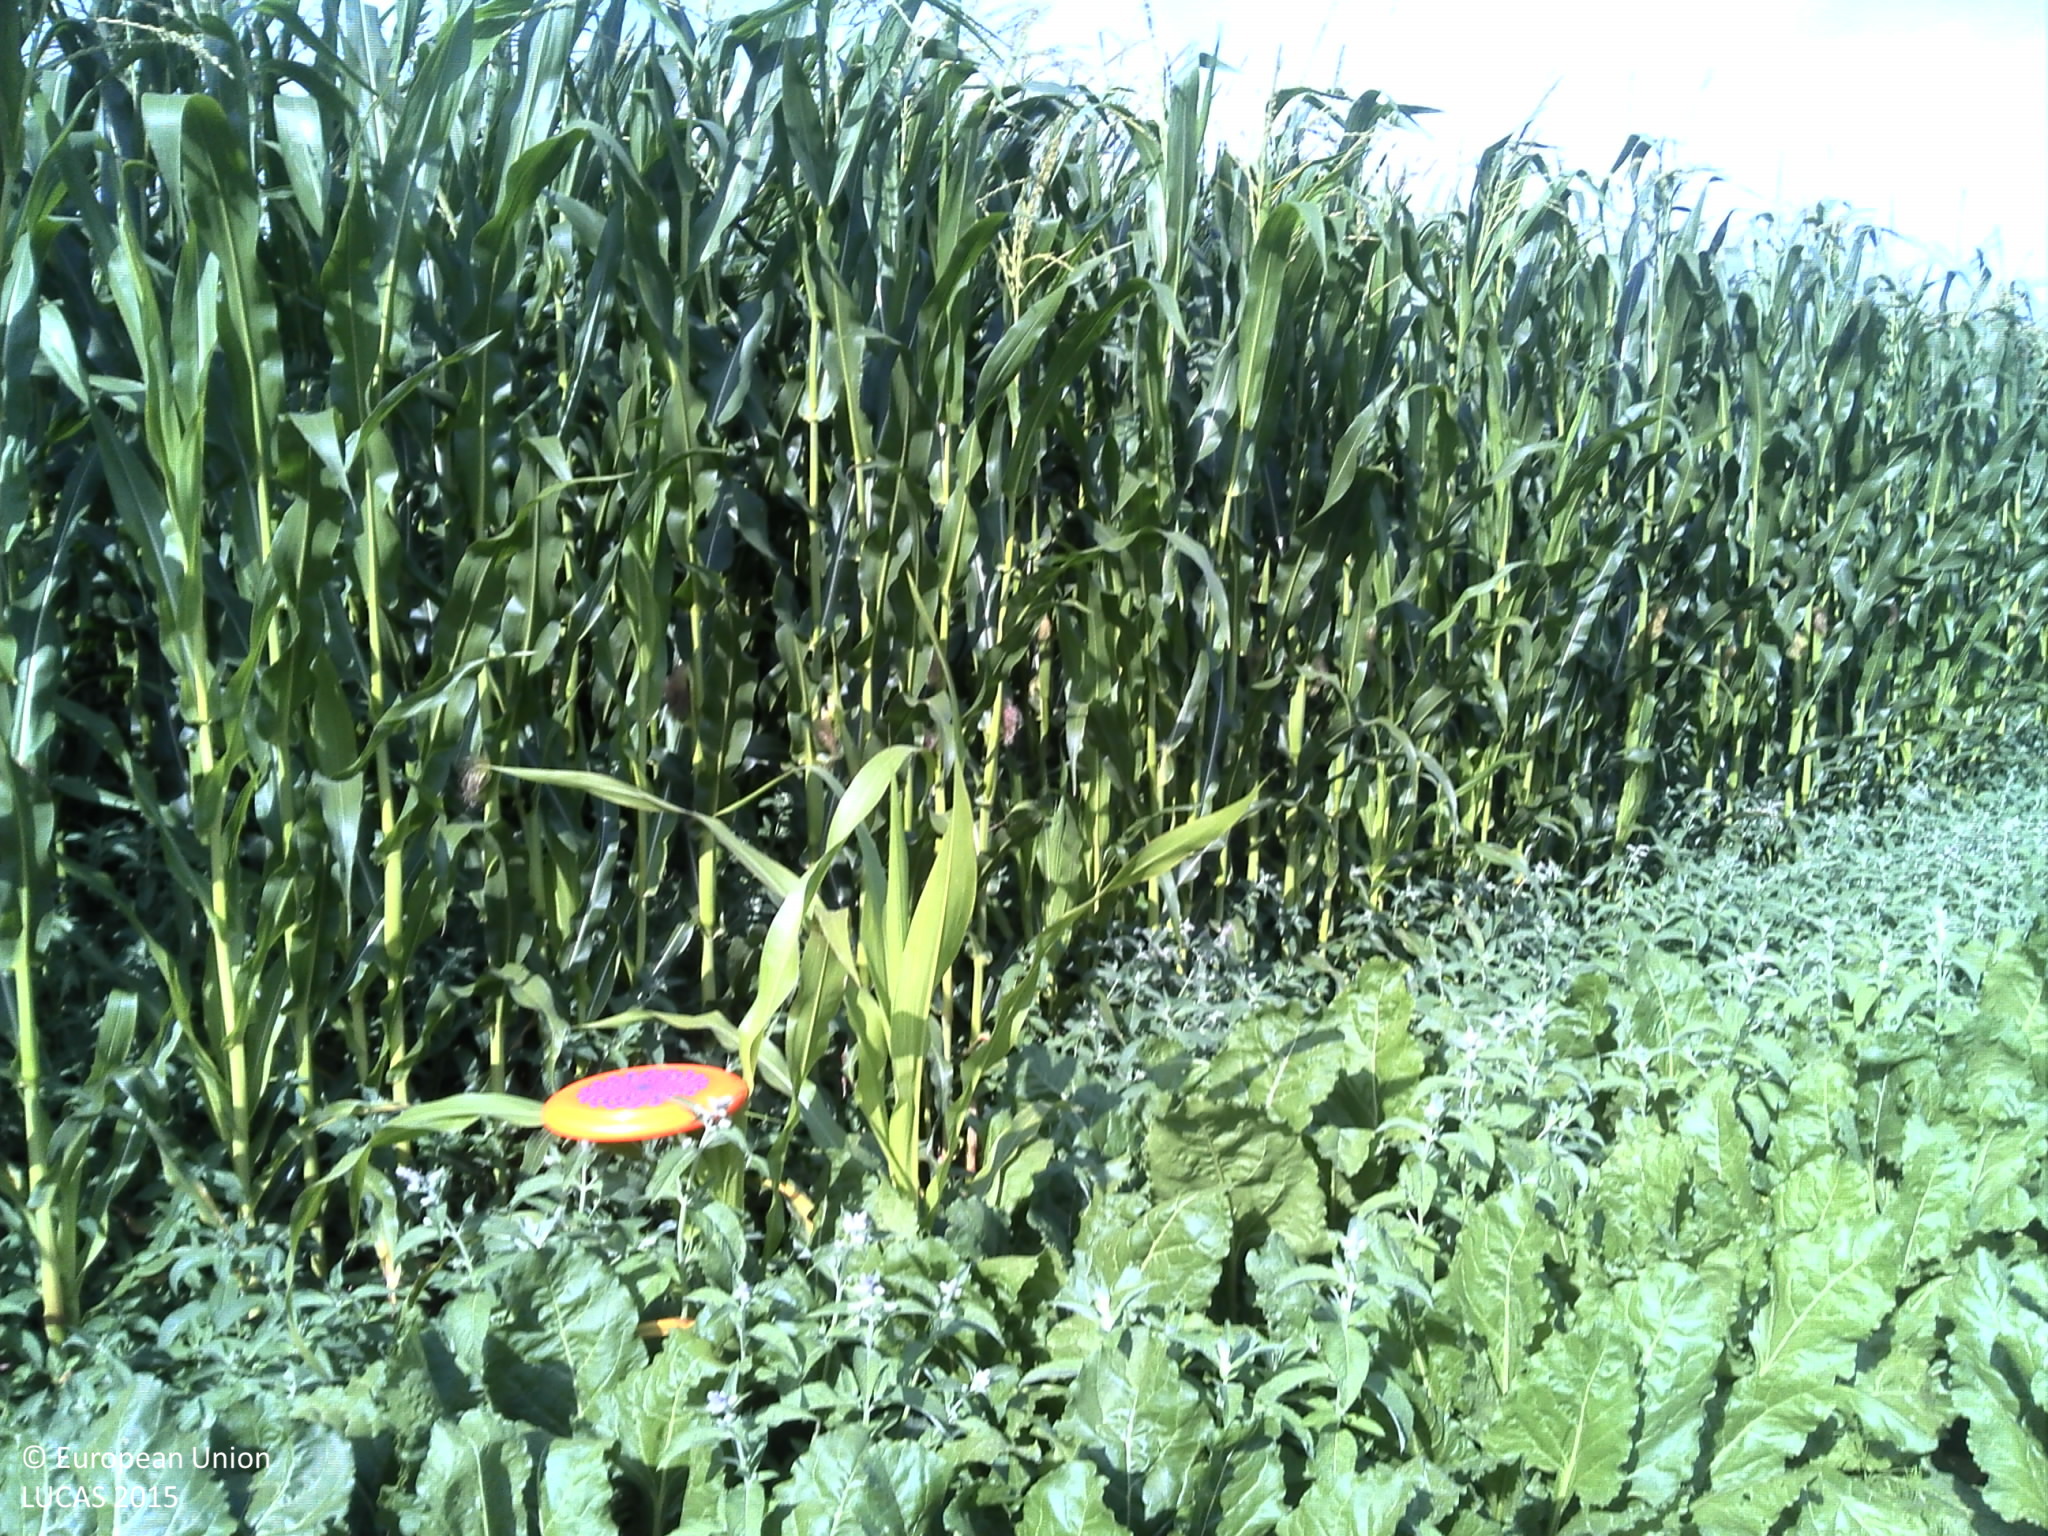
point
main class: Cropland
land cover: Maize
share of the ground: > 75 %
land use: Agriculture (excluding fallow land and kitchen gardens)
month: July
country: FR
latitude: 45.8708
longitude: 3.3141
